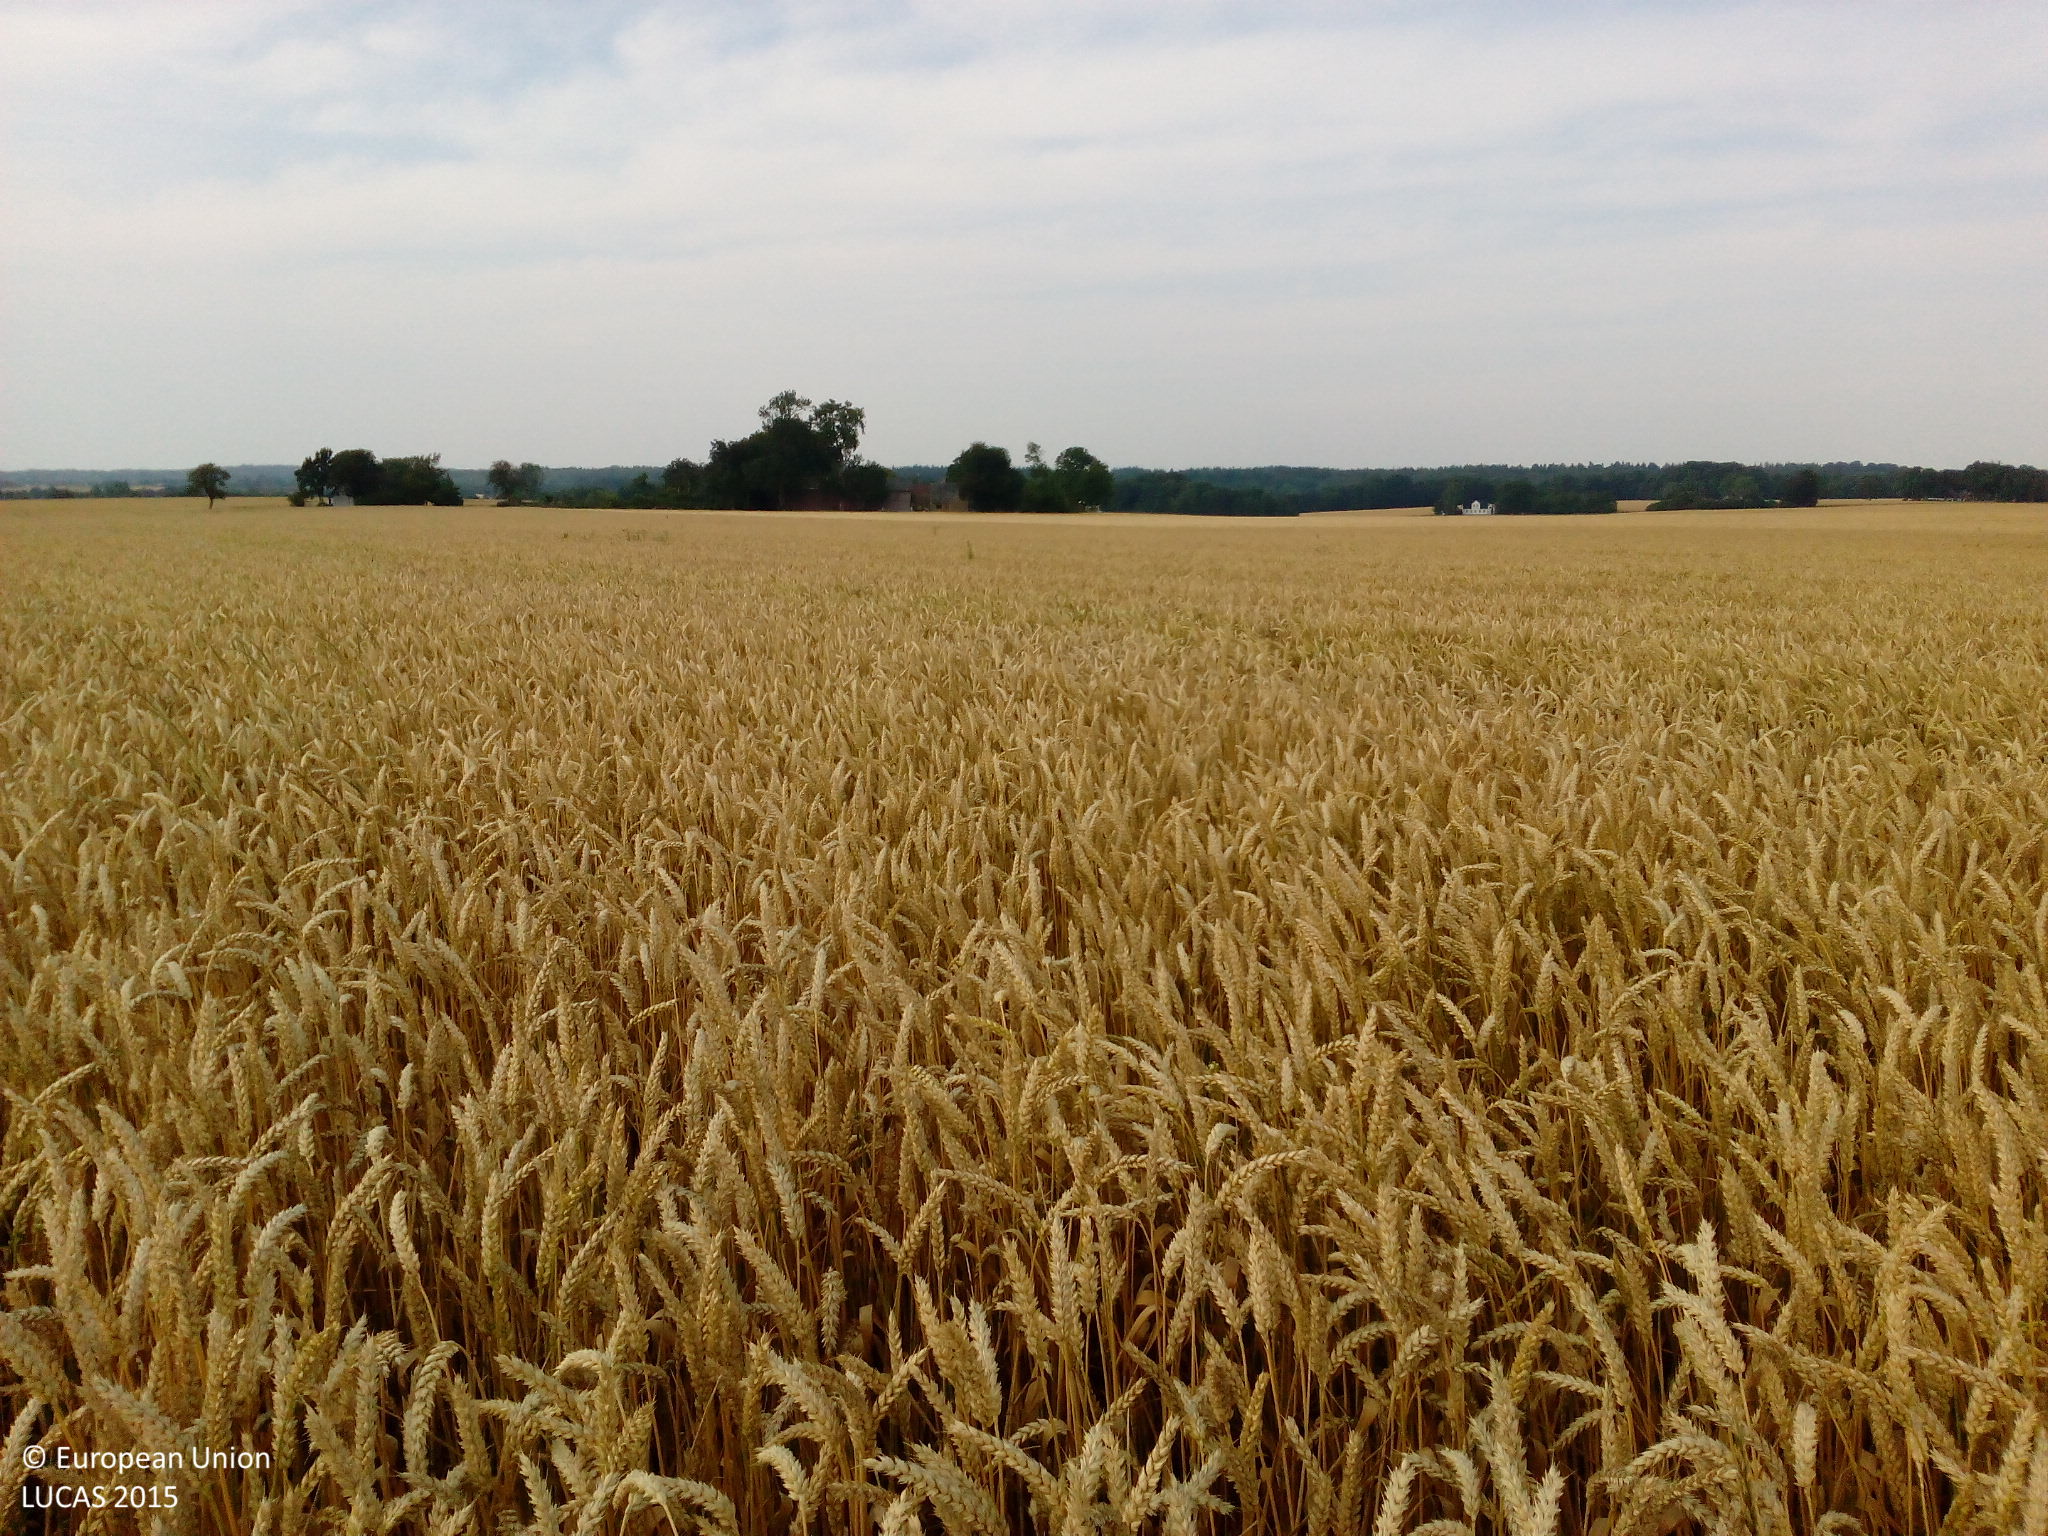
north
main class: Cropland
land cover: Common wheat
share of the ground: > 75 %
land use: Agriculture (excluding fallow land and kitchen gardens)
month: August
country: DK
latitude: 55.4741
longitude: 11.7862
